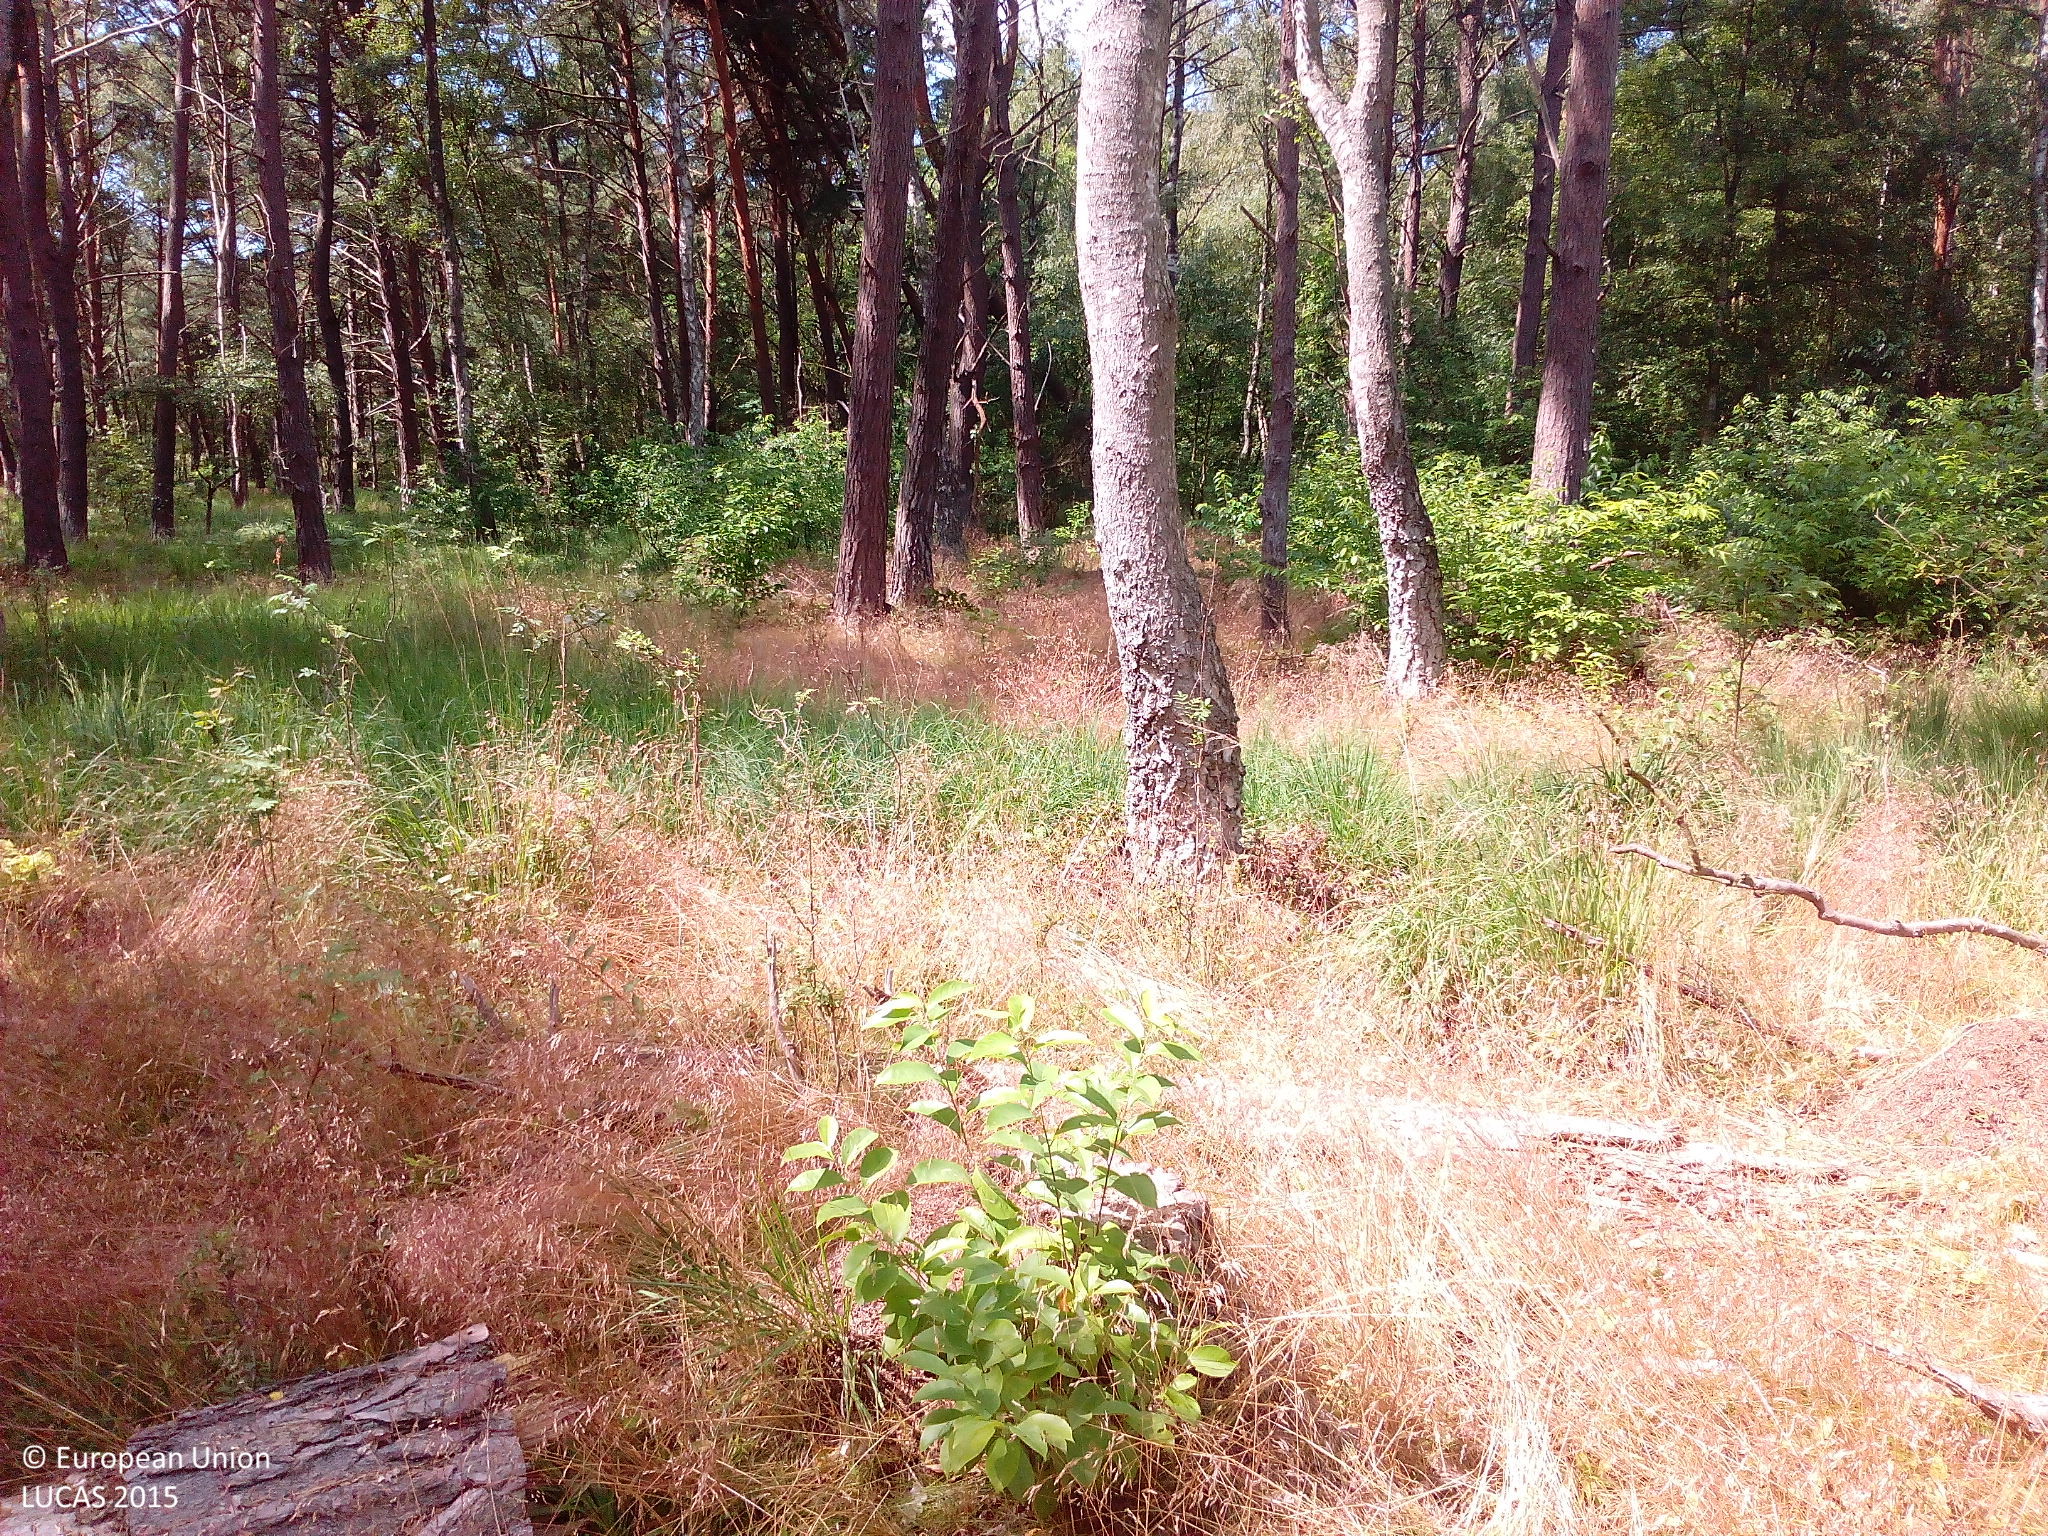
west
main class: Woodland
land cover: Broadleaved woodland
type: mesophytic deciduous forest
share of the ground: 50 - 75 %
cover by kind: broadleaved forest trees 60 %, herbaceous plants 35 %, coniferous forest trees 5 %
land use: Semi-natural and natural areas not in use
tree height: > 5 m
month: July
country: DE
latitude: 54.4336
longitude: 12.6659
